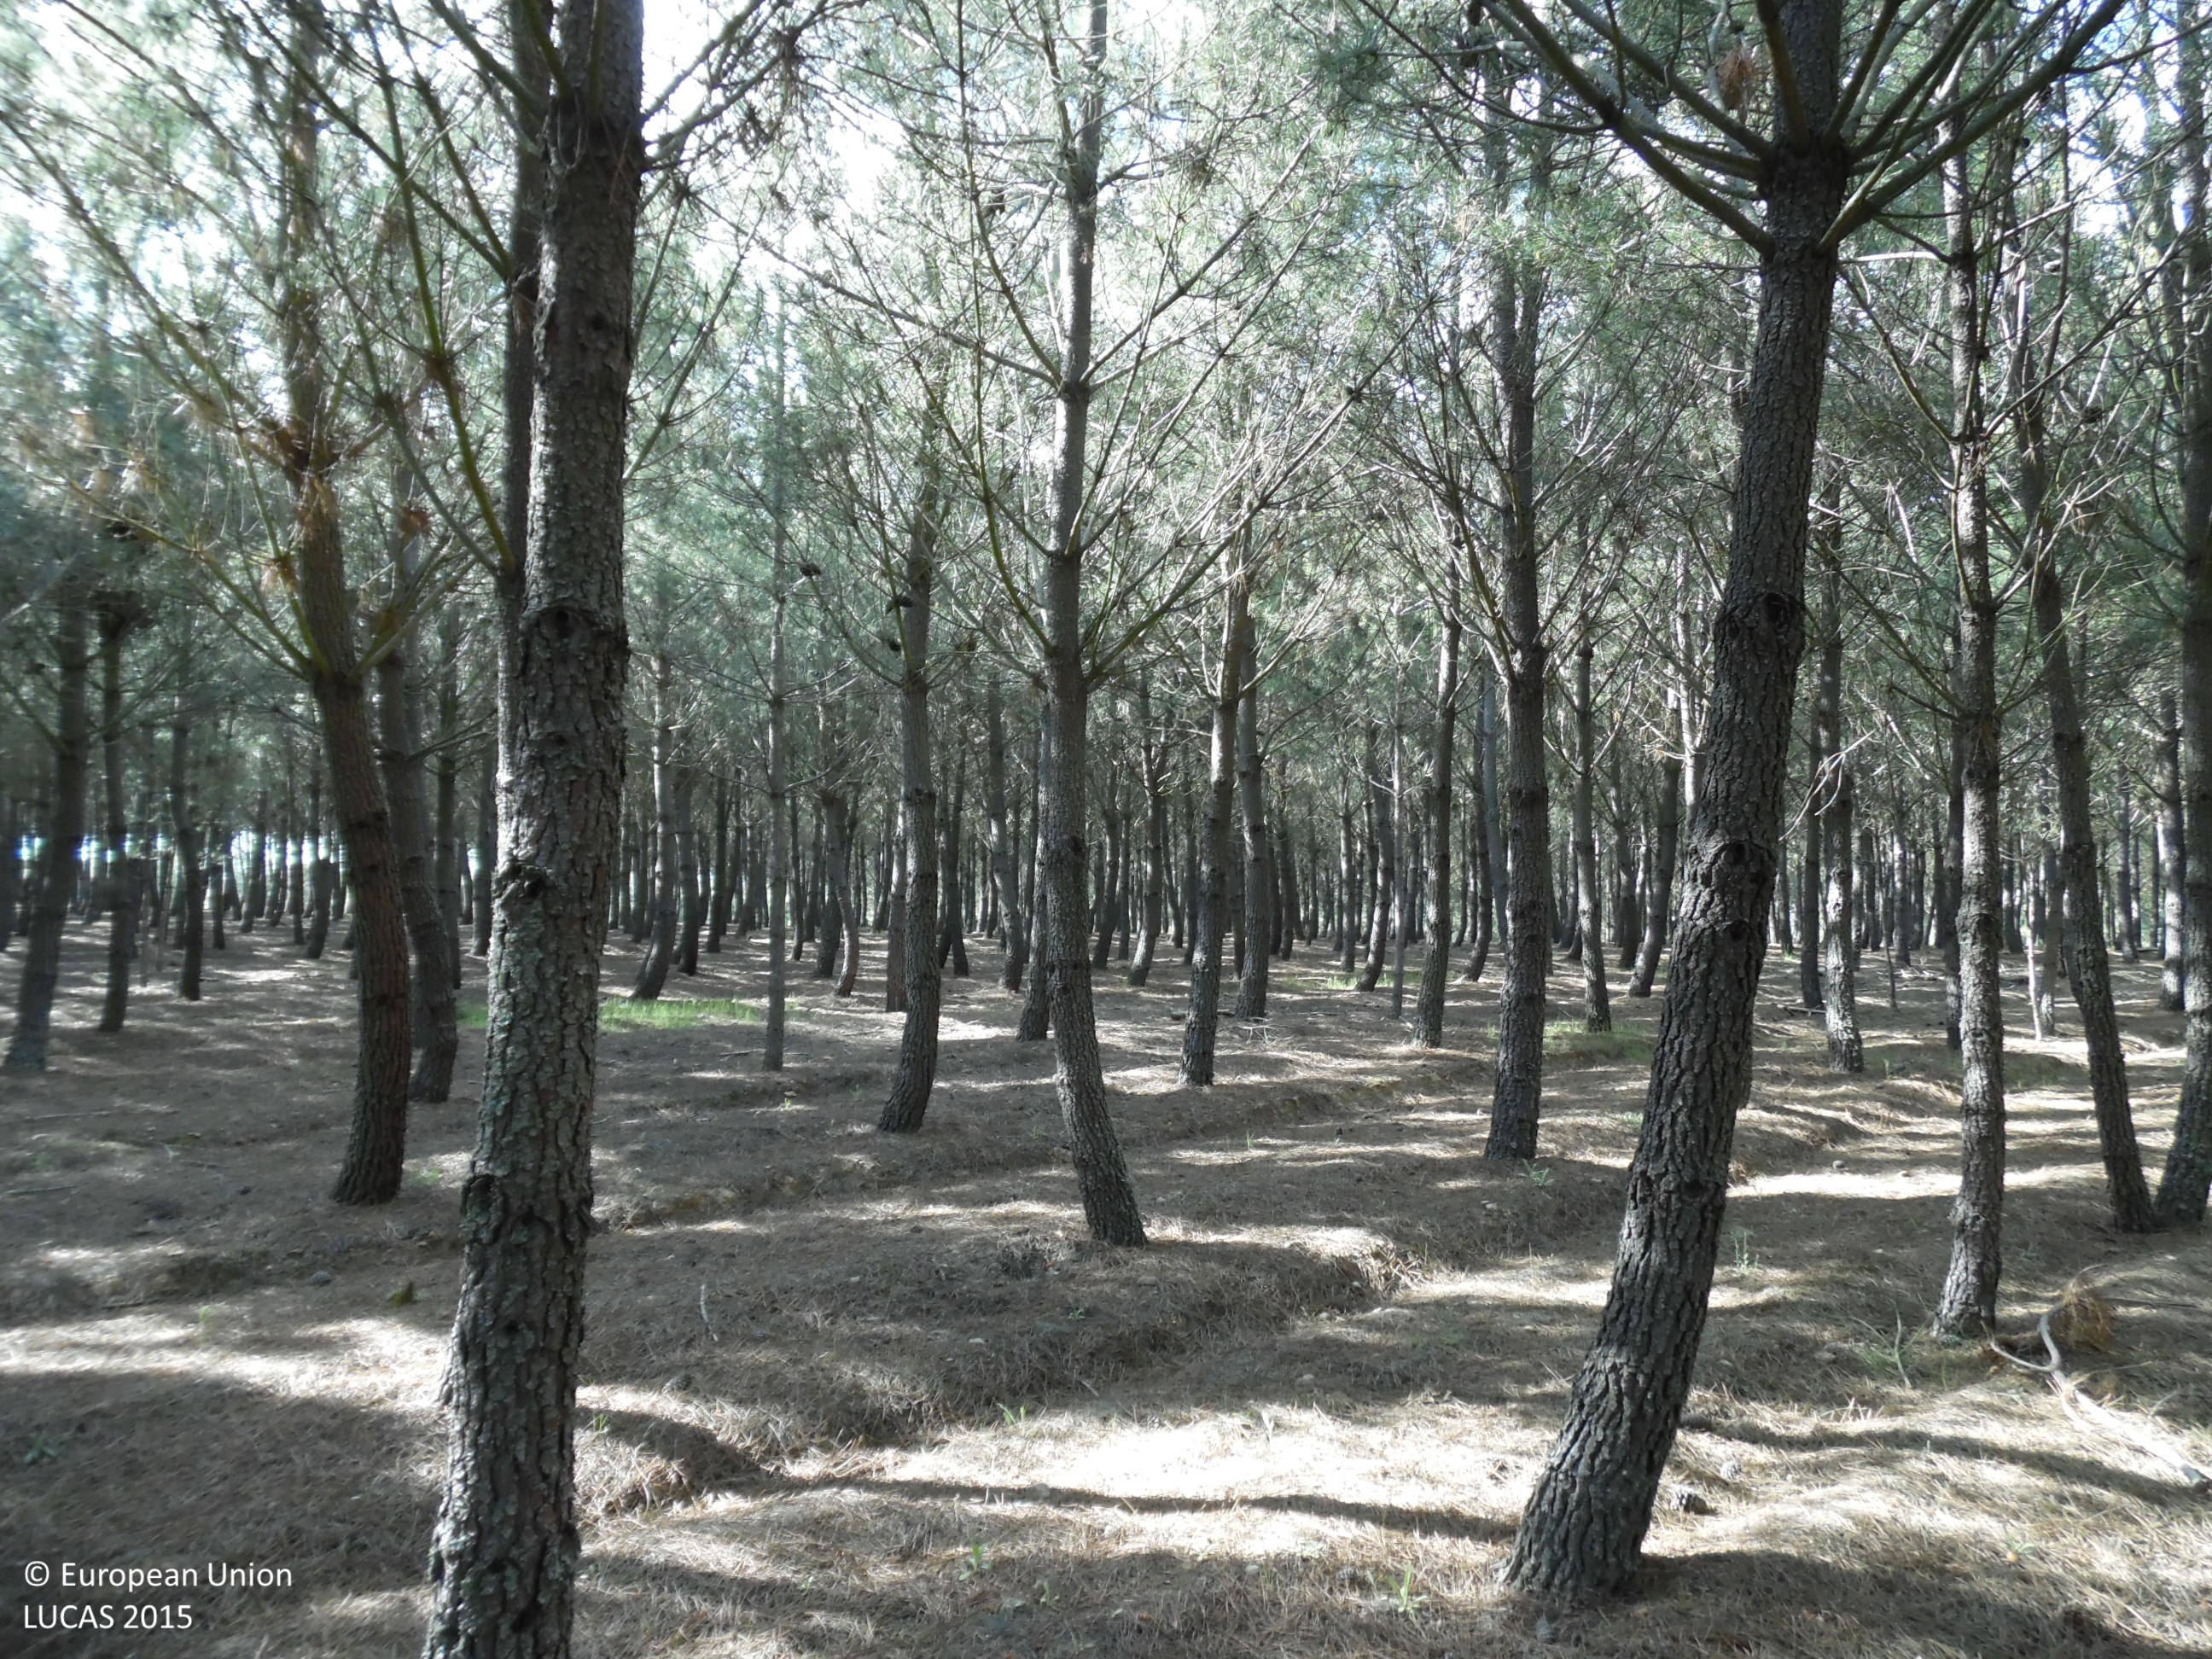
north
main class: Woodland
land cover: Pine dominated coniferous woodland
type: coniferous forest of the mediterranean region
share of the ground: > 75 %
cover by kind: coniferous forest trees 100 %
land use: Forestry
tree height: > 5 m
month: April
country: ES
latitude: 42.2403
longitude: -6.0880
